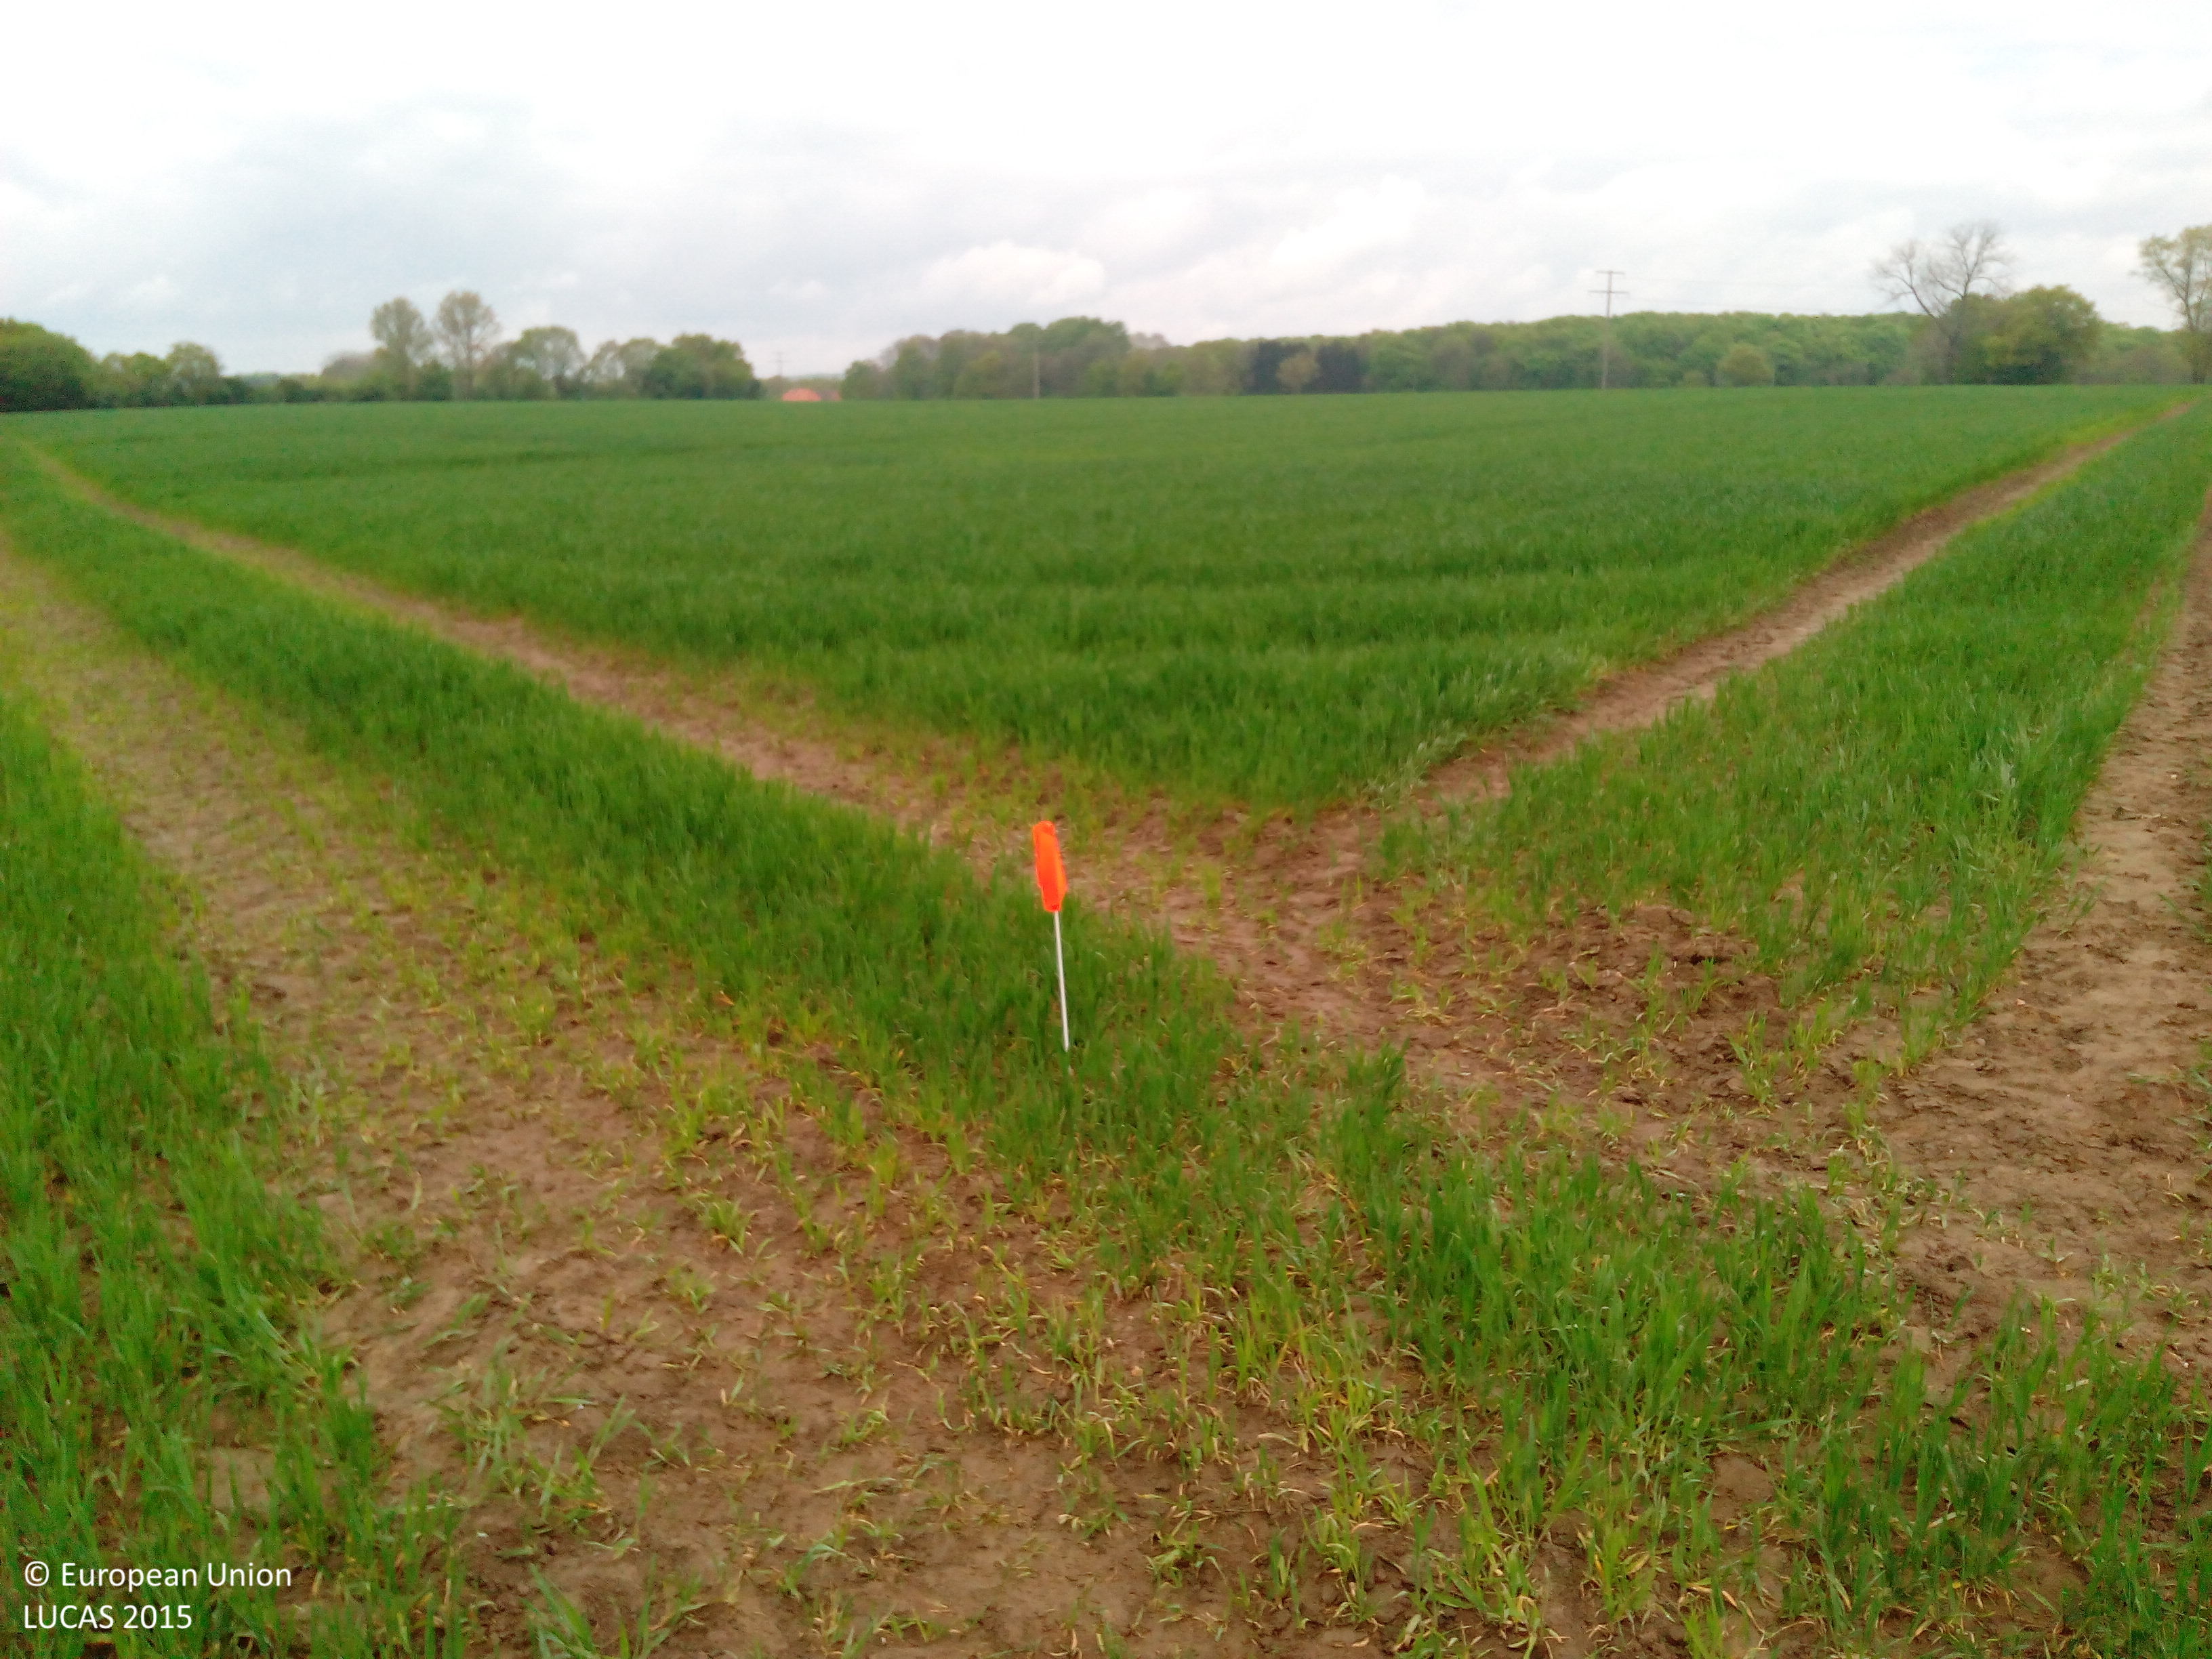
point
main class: Cropland
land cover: Common wheat
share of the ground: > 75 %
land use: Agriculture (excluding fallow land and kitchen gardens)
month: May
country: DE
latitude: 51.9174
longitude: 7.3978
